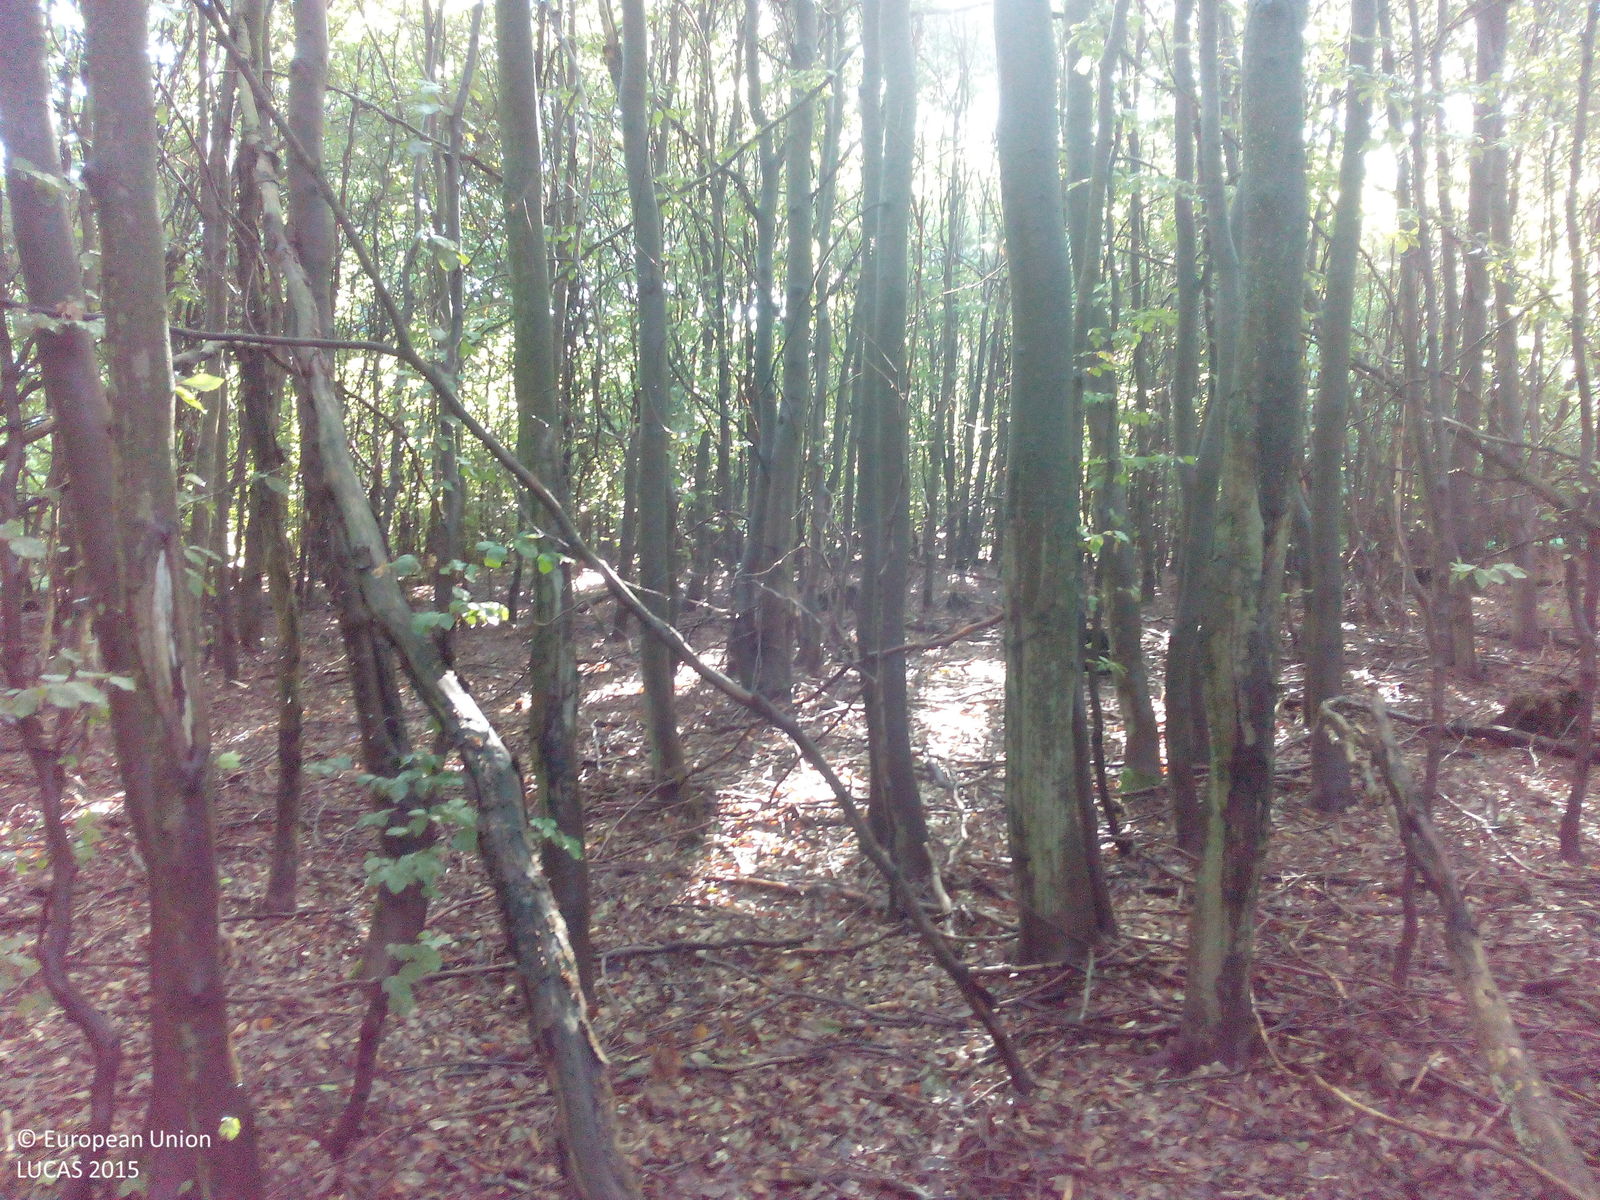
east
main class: Woodland
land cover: Broadleaved woodland
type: beech forest
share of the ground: > 75 %
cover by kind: broadleaved forest trees 100 %
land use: Forestry
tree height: > 5 m
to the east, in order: Broadleaved woodland; Grassland without tree/shrub cover; Broadleaved woodland; Grassland without tree/shrub cover; Broadleaved woodland
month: August
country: DE
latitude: 51.7086
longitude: 10.9404
